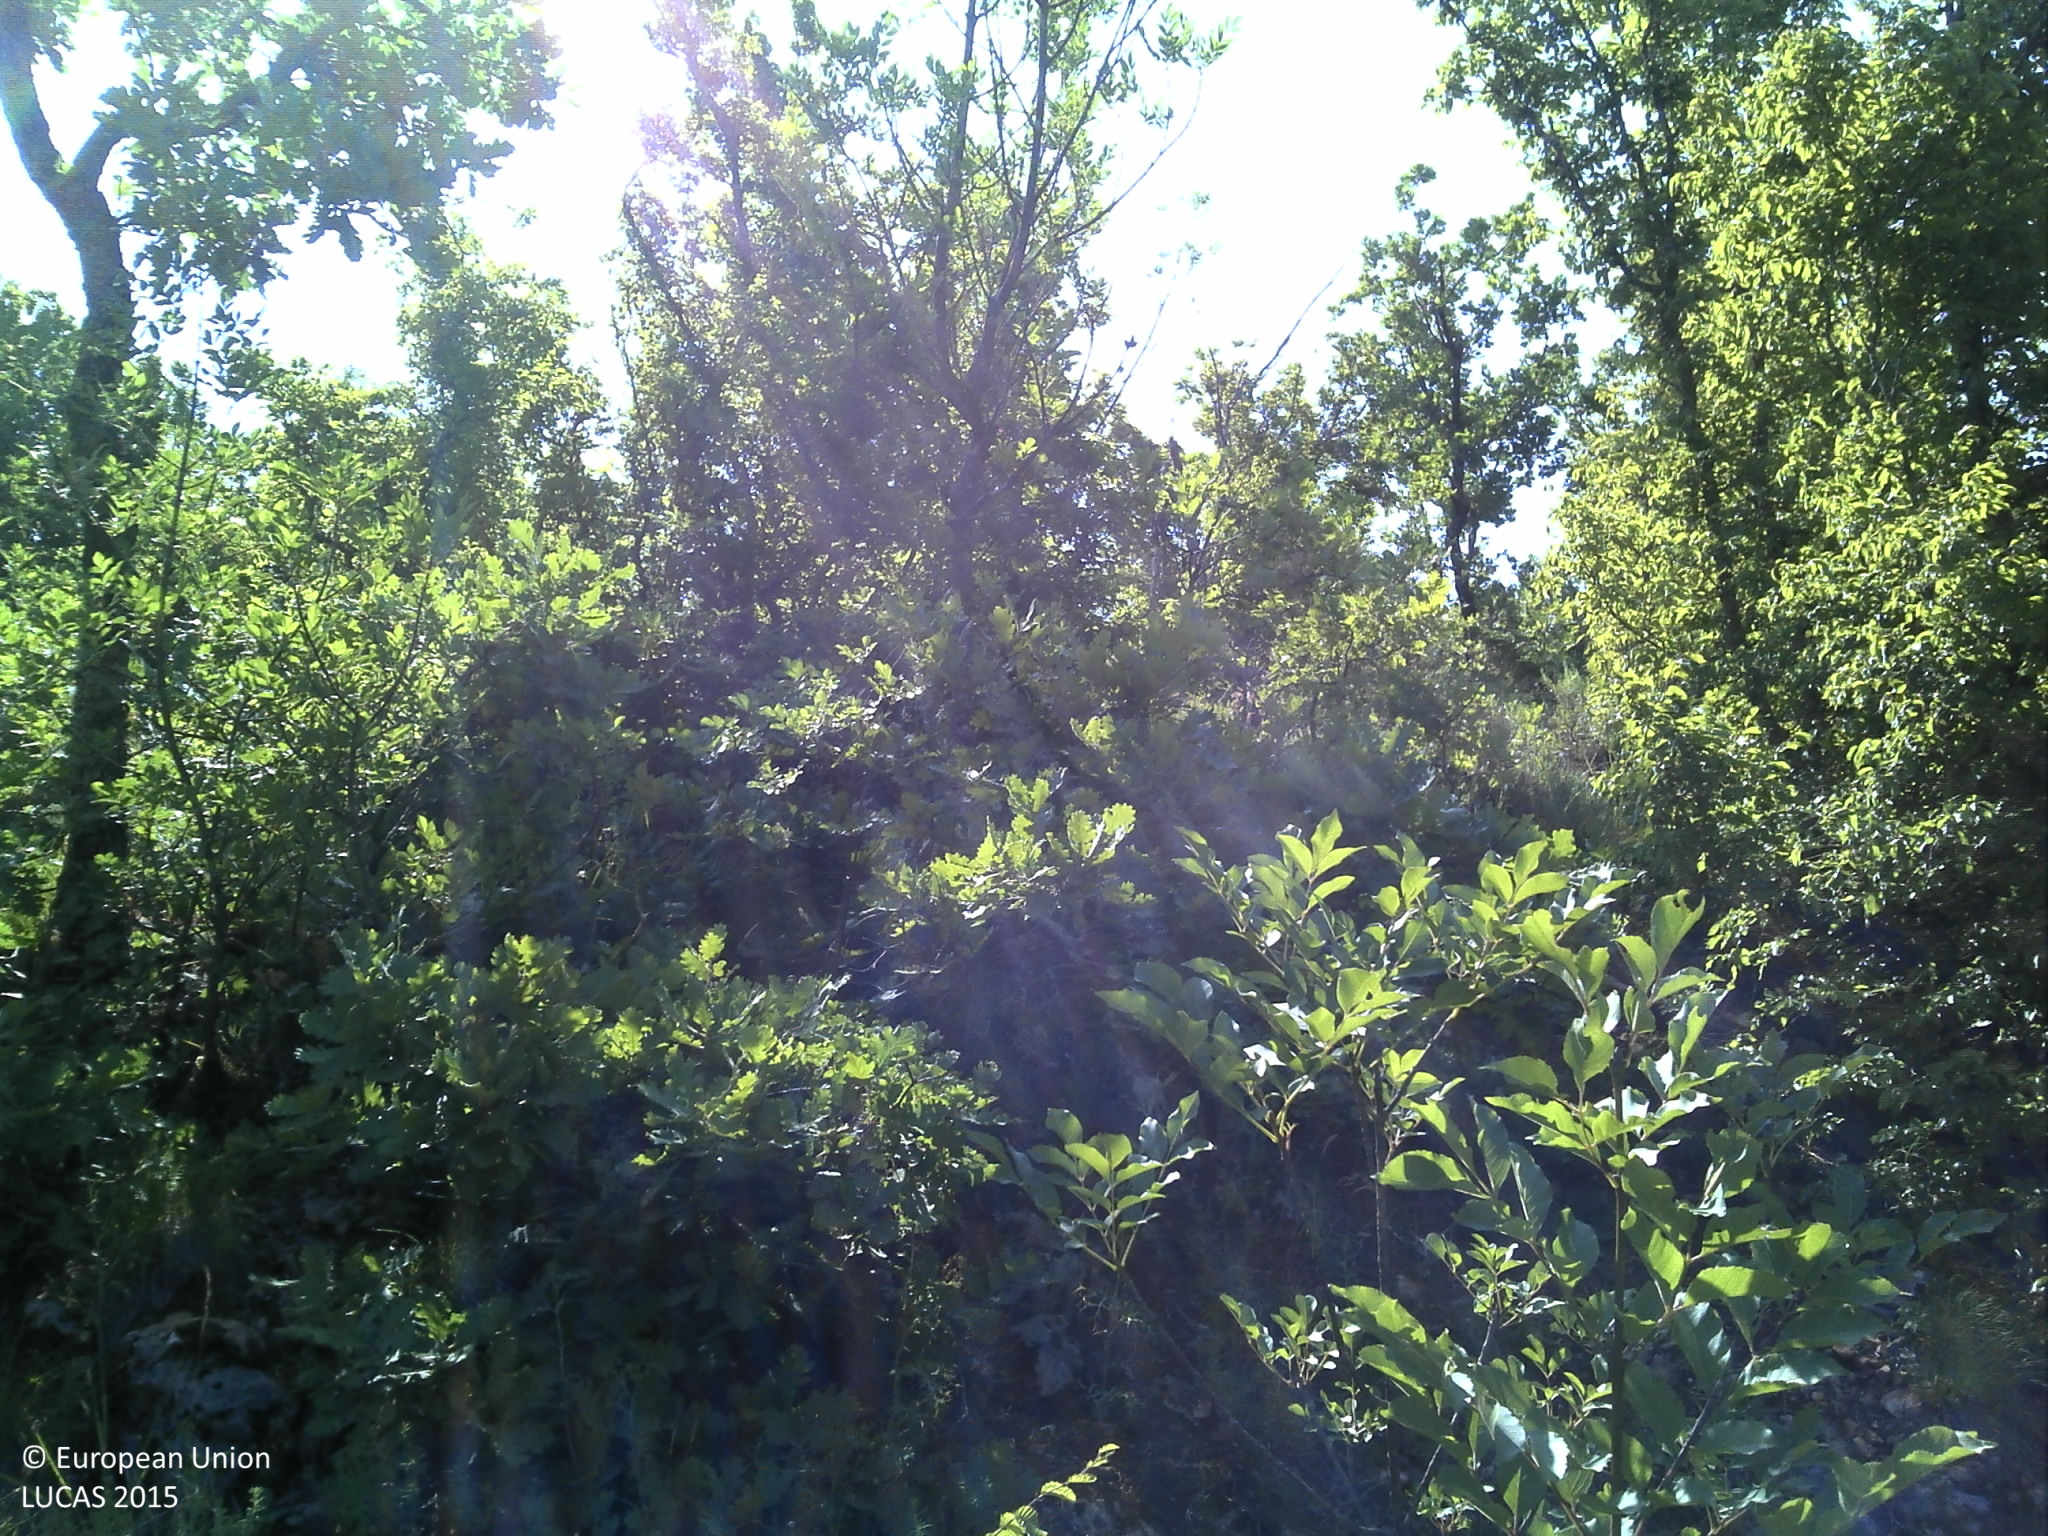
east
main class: Woodland
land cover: Broadleaved woodland
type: thermophilous deciduous forest
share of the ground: 50 - 75 %
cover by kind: broadleaved forest trees 45 %, shrubs 25 %, unconsolidated bare surface 15 %, herbaceous plants 10 %, consolidated bare surface 5 %
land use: Semi-natural and natural areas not in use
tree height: > 5 m
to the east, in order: Broadleaved woodland; Dry stone walls; Broadleaved woodland; Dry stone walls; Shrubland with sparse tree cover; Dry stone walls; Shrubland with sparse tree cover
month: July
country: HR
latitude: 44.0313
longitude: 16.3187
